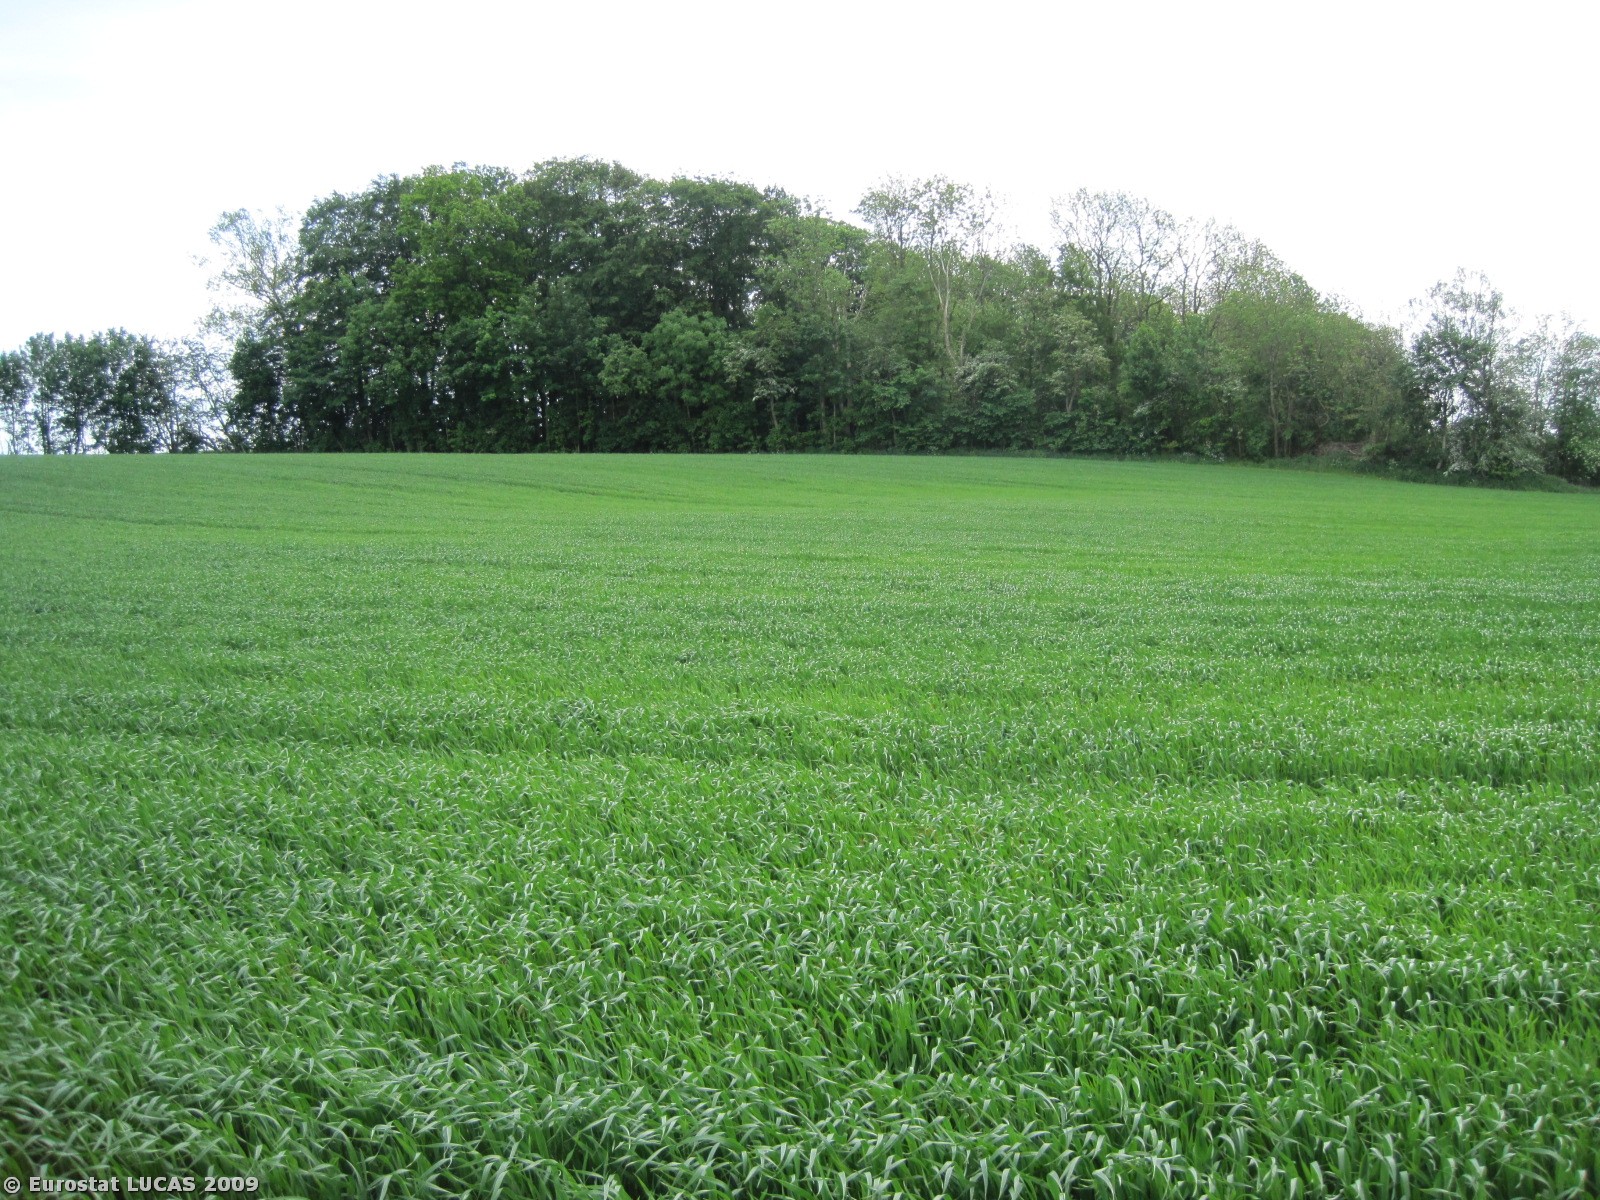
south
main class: Cropland
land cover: Oats
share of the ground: > 75 %
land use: Agriculture (excluding fallow land and kitchen gardens)
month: May
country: DK
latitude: 56.5113
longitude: 10.0487
